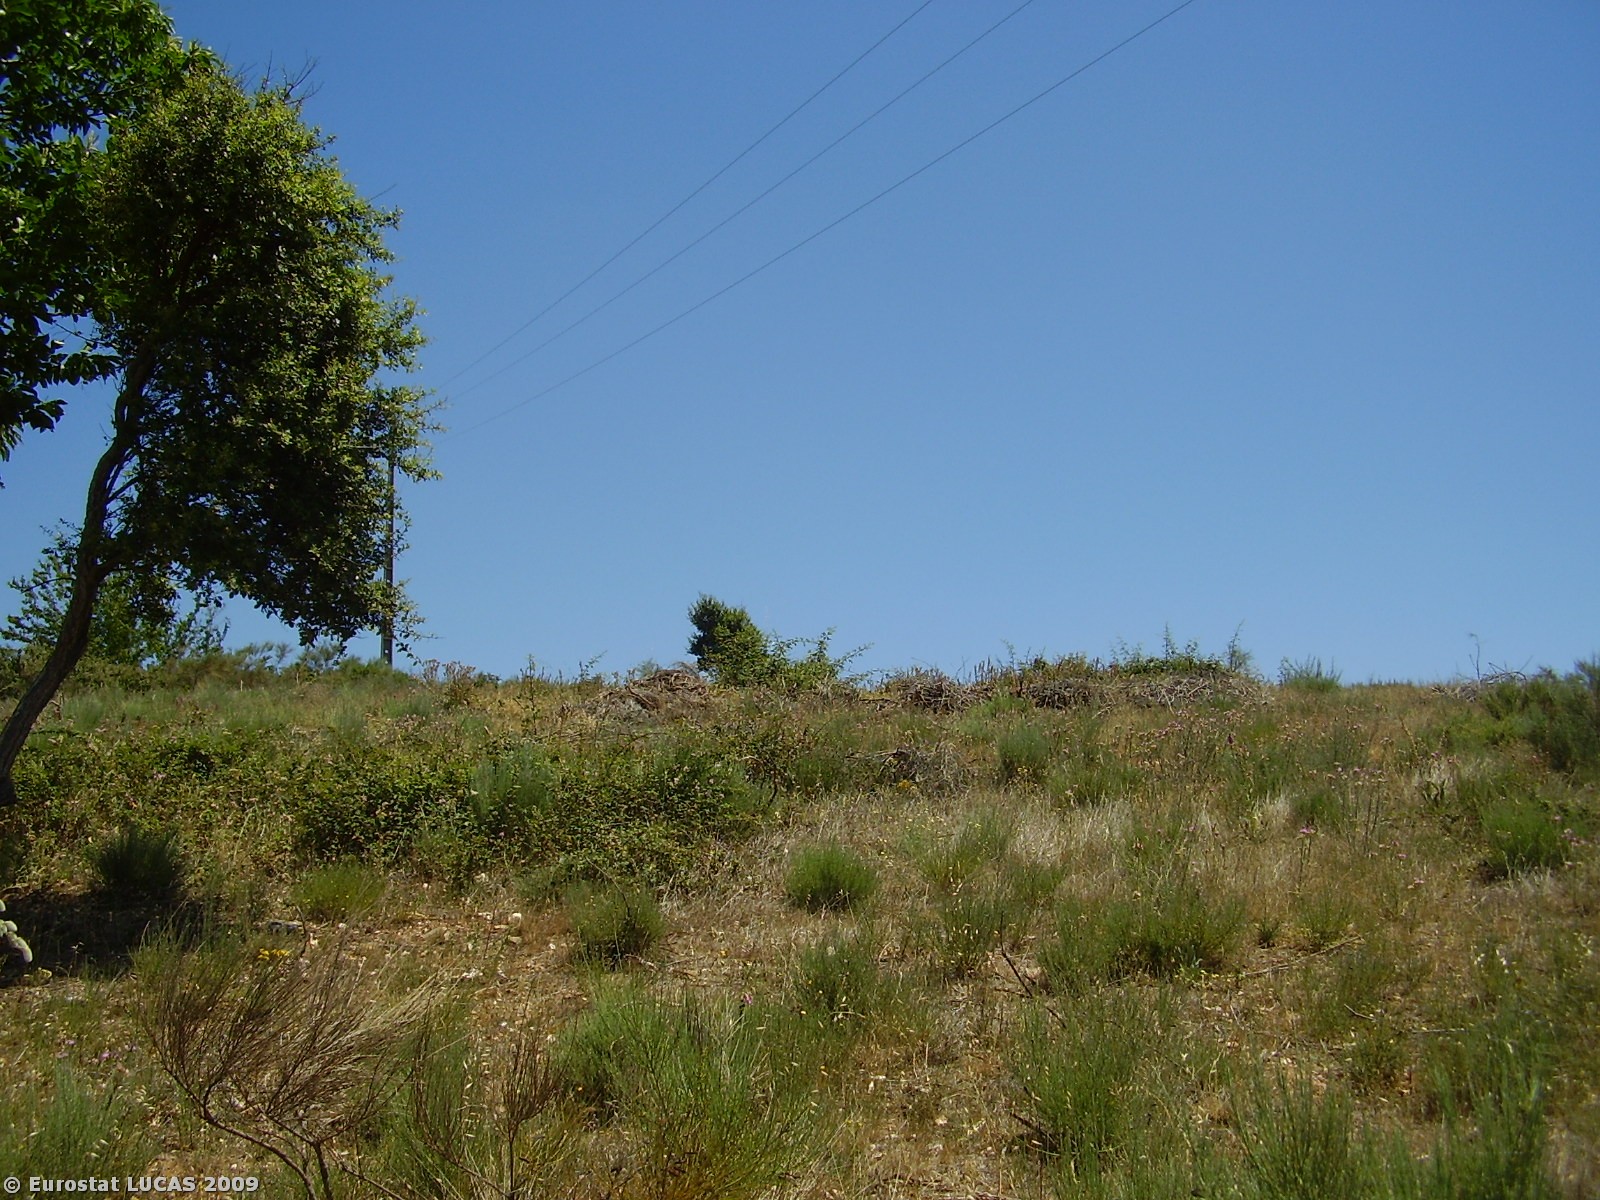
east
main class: Shrubland
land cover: Shrubland with sparse tree cover
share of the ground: 10 - 25 %
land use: Unused
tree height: > 5 m
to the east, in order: Shrubland with sparse tree cover; Spontaneously vegetated surfaces; Shrubland with sparse tree cover; Electric lines; Shrubland with sparse tree cover; Shruby margins; Abandoned hedges; Shruby margins; Mixed cereals for fodder; Shruby margins; Electric lines; Paved roads, cycling and walking lanes
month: June
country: PT
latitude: 41.5801
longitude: -6.5246
